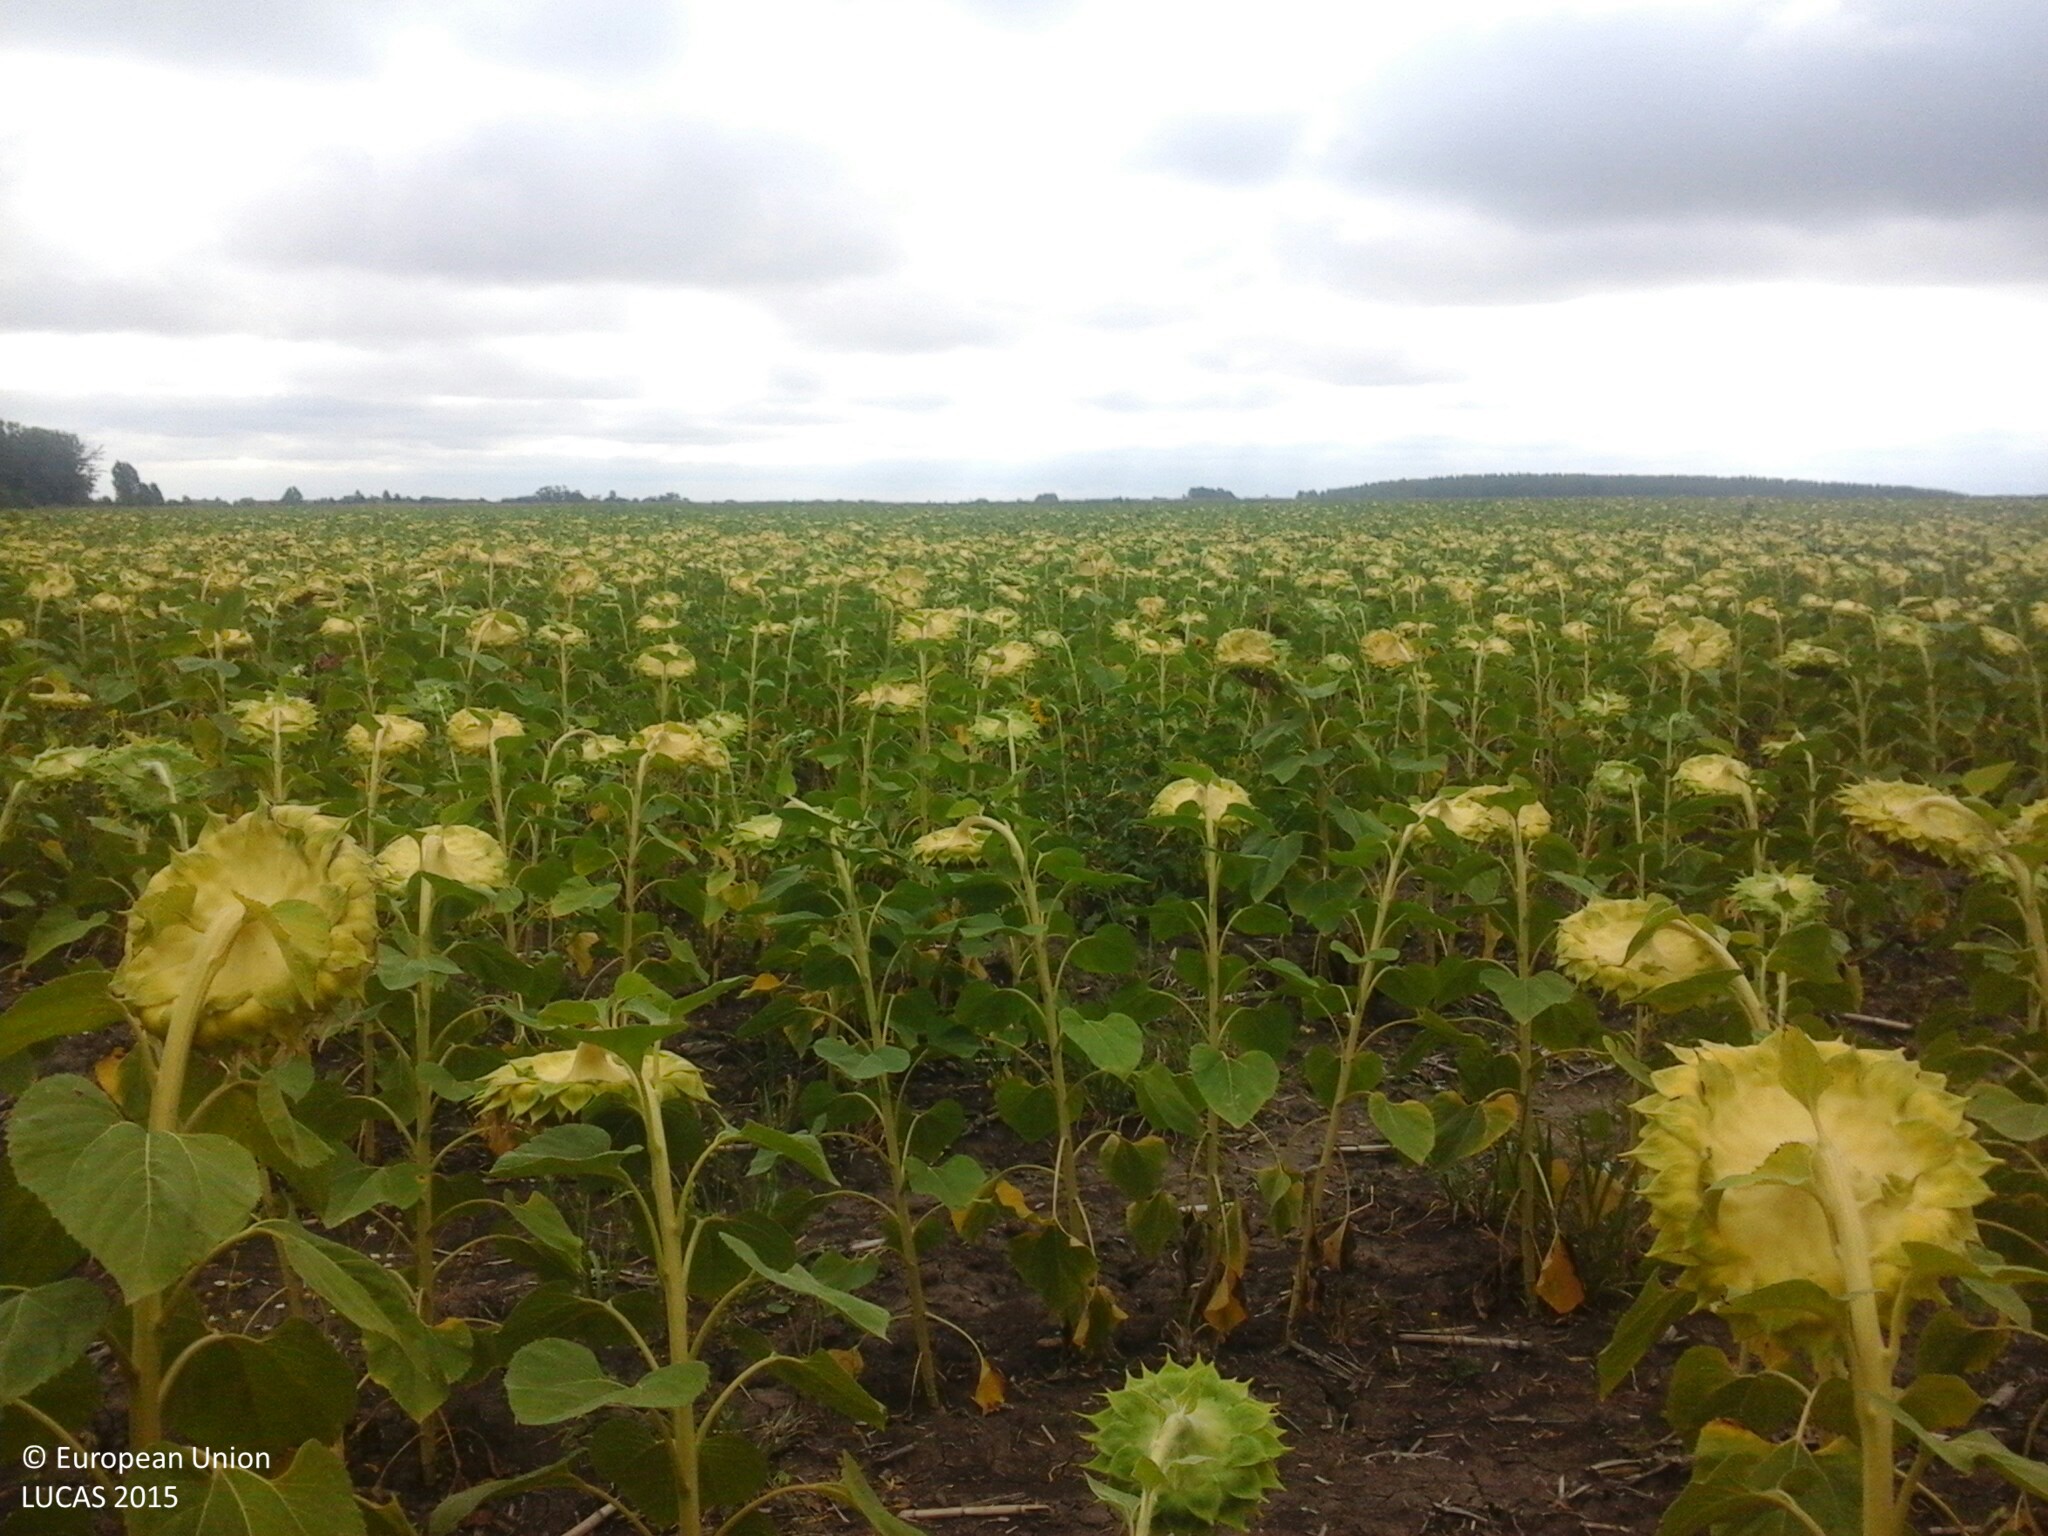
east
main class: Cropland
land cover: Sunflower
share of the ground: 50 - 75 %
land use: Agriculture (excluding fallow land and kitchen gardens)
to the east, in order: Sunflower
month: August
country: HU
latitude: 47.0170
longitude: 21.5253
